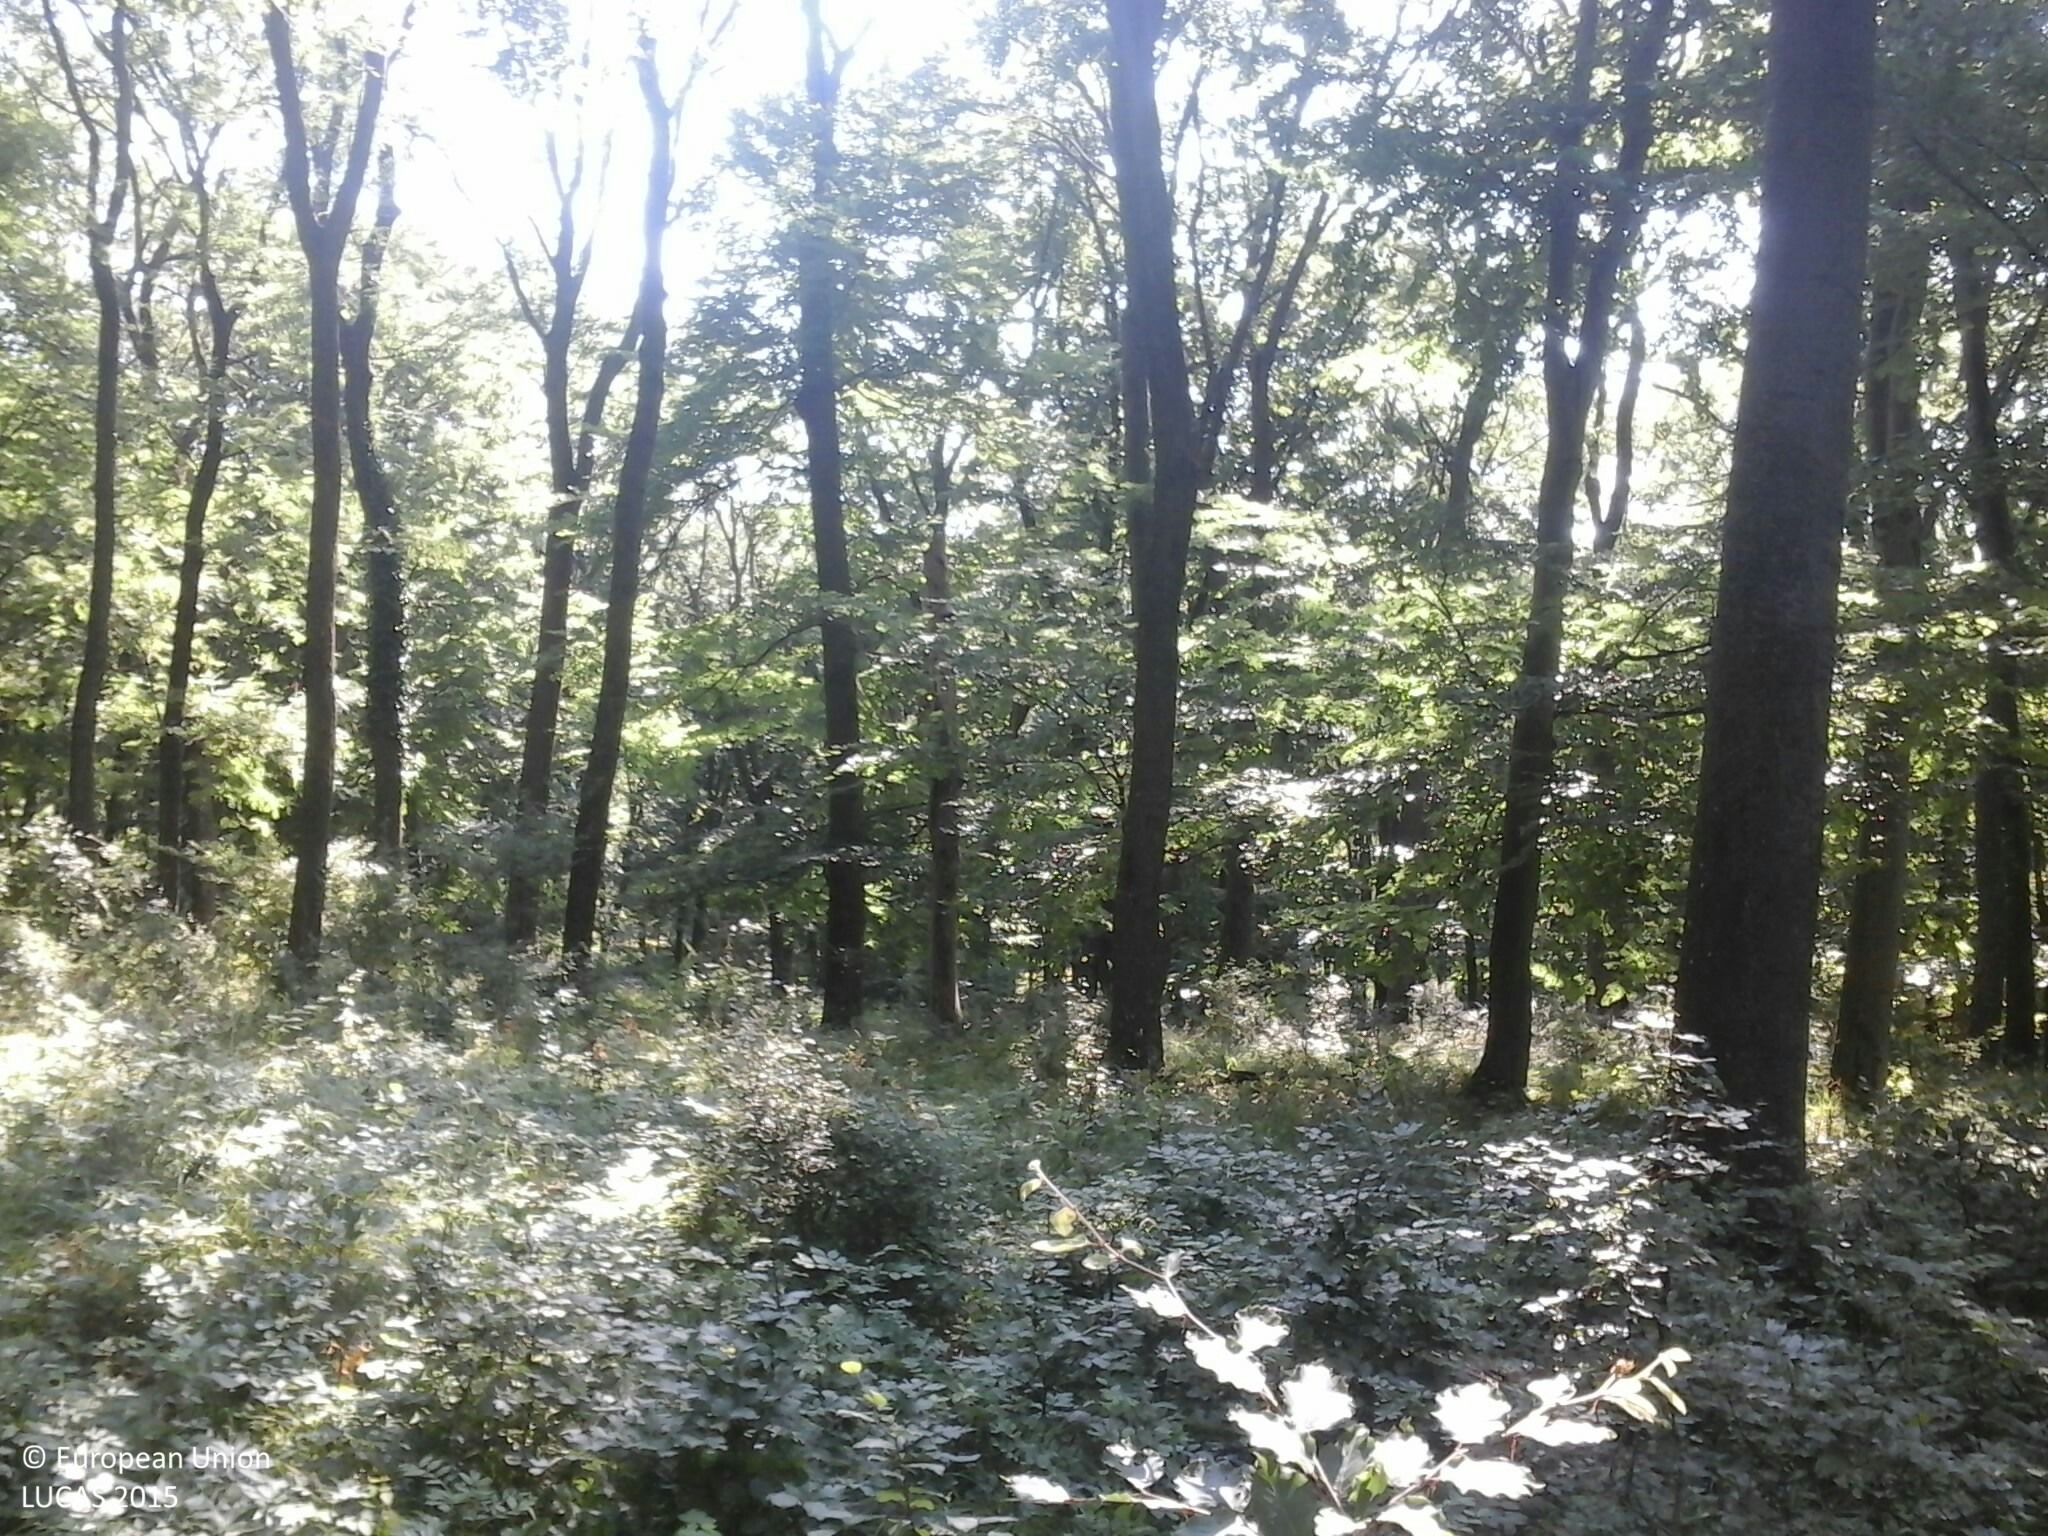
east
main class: Woodland
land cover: Broadleaved woodland
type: beech forest
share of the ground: > 75 %
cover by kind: broadleaved forest trees 95 %, herbaceous plants 5 %
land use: Forestry
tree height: > 5 m
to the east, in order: Broadleaved woodland; Tracks; Broadleaved woodland; Tracks; Broadleaved woodland
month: July
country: HU
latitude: 47.1672
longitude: 17.8318
